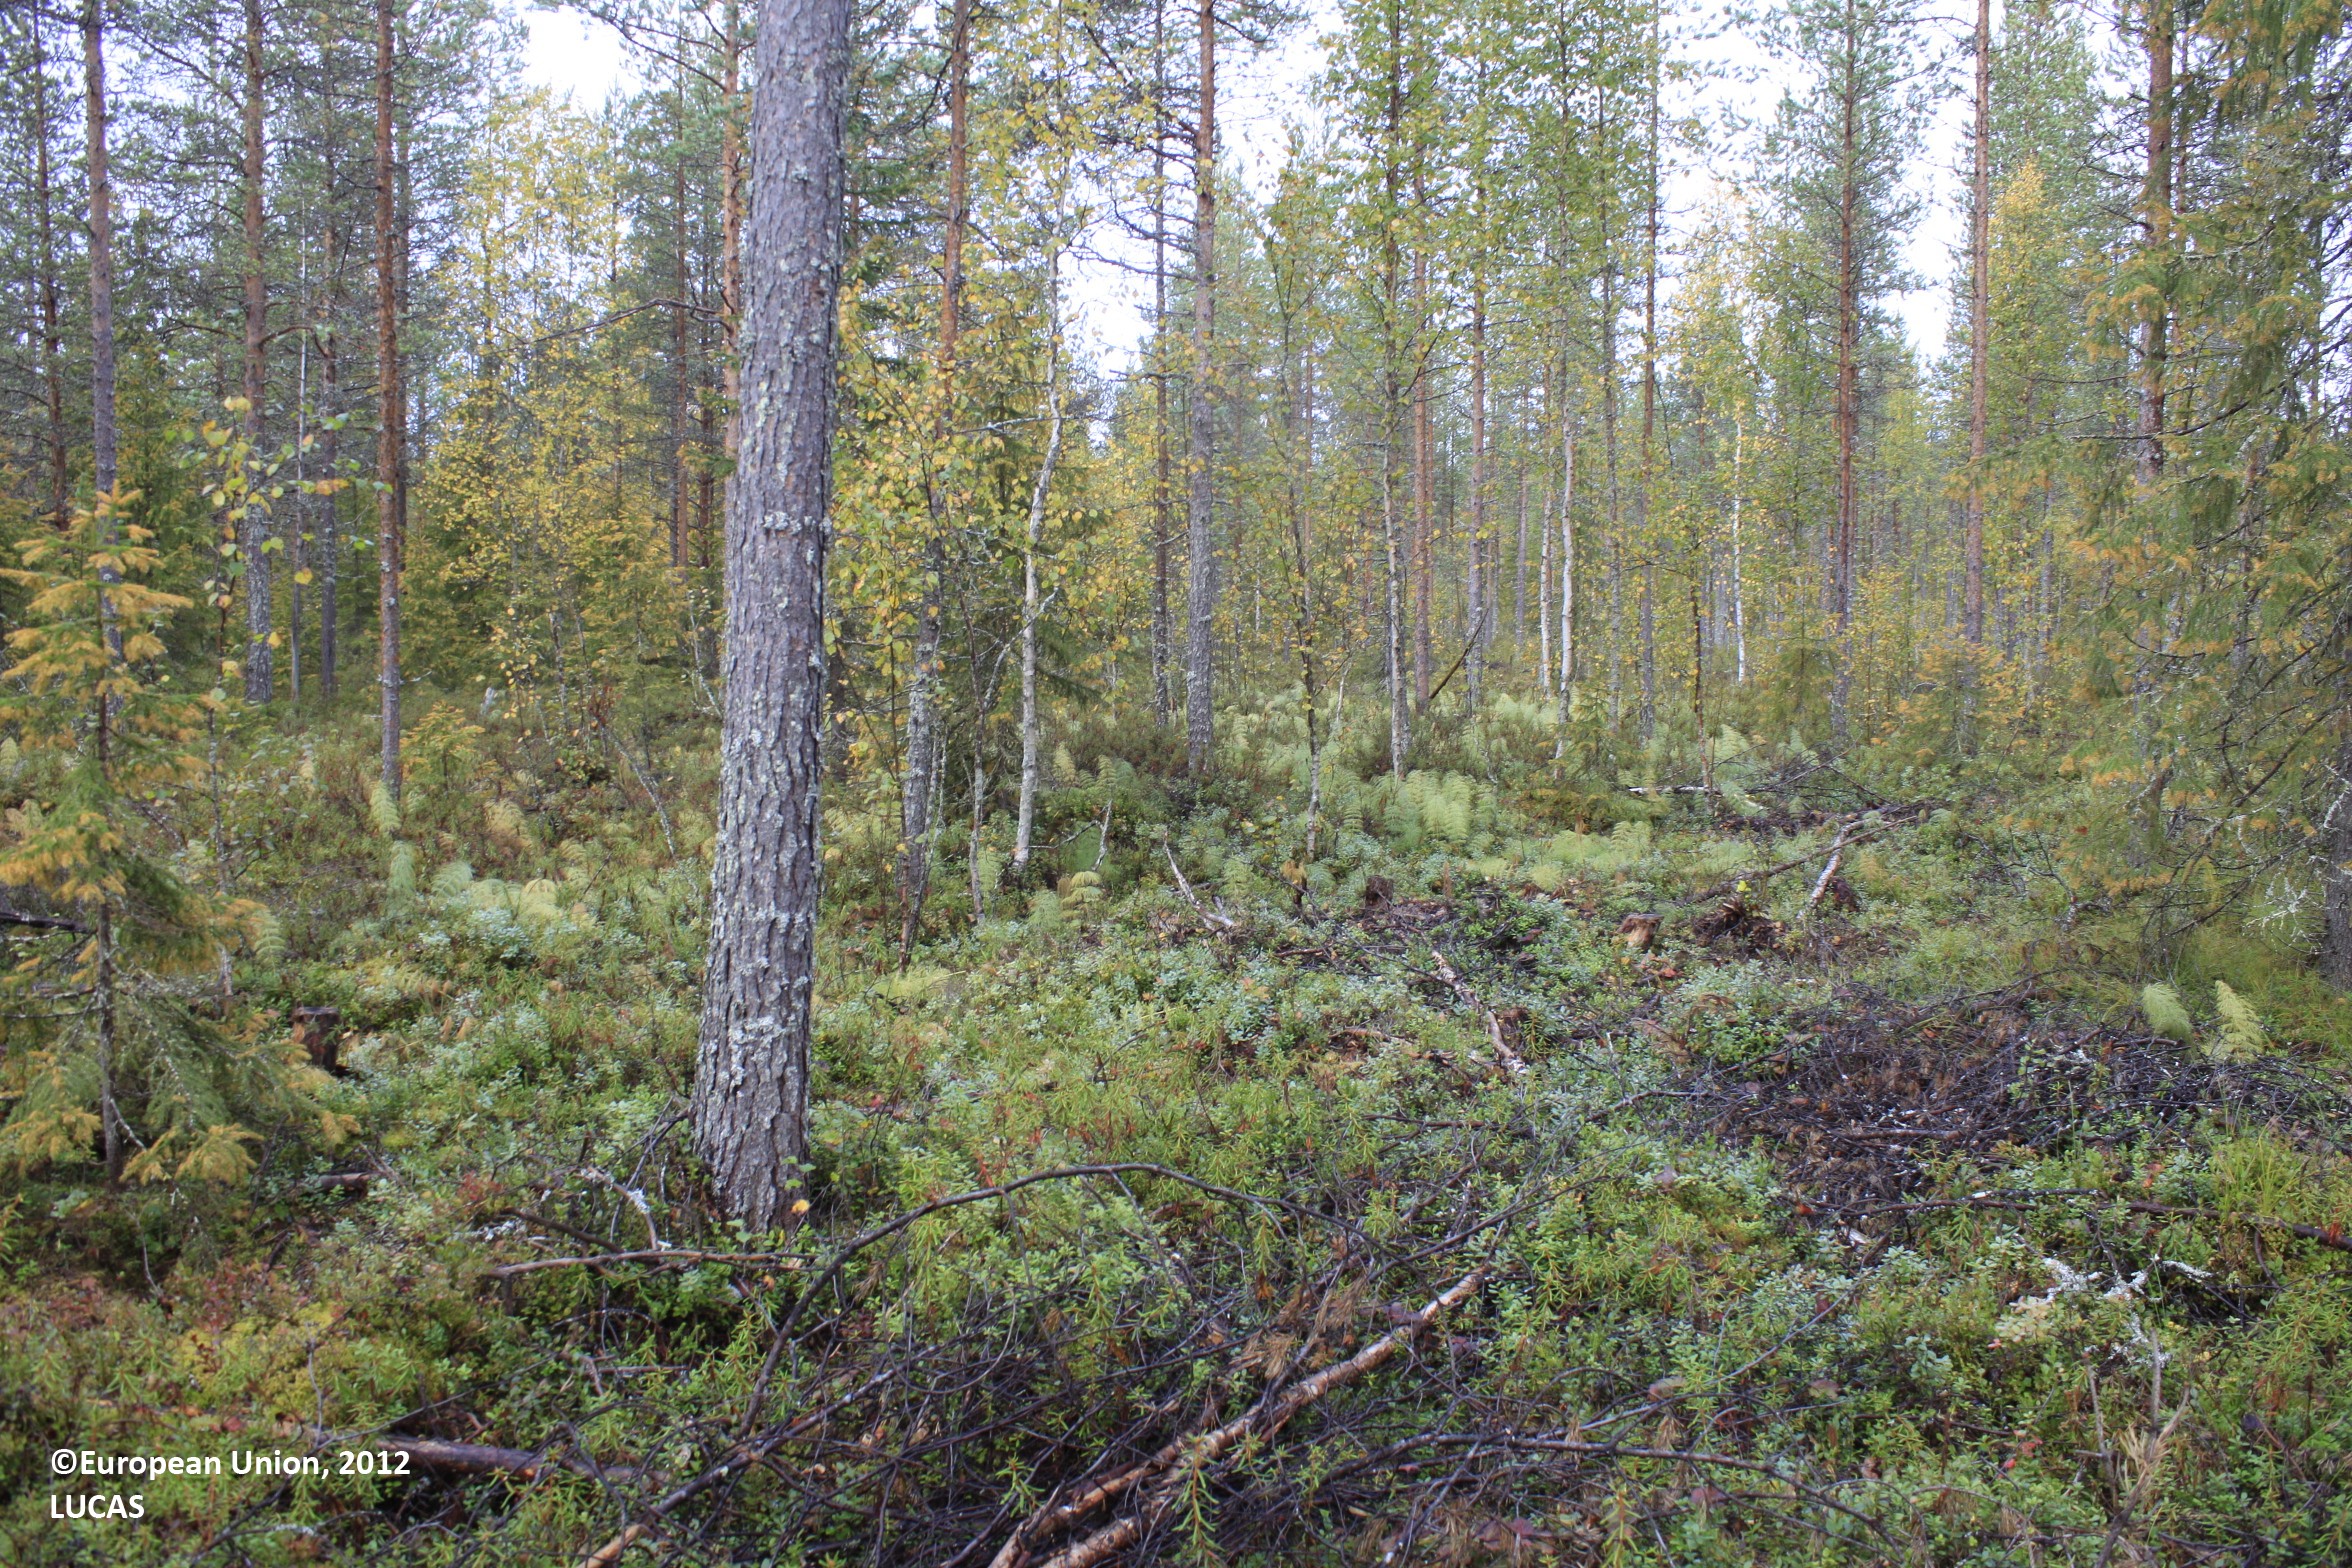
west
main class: Woodland
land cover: Pine dominated mixed woodland
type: boreal forest
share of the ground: 25 - 50 %
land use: Forestry
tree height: > 5 m
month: September
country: FI
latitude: 65.5406
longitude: 26.5744
